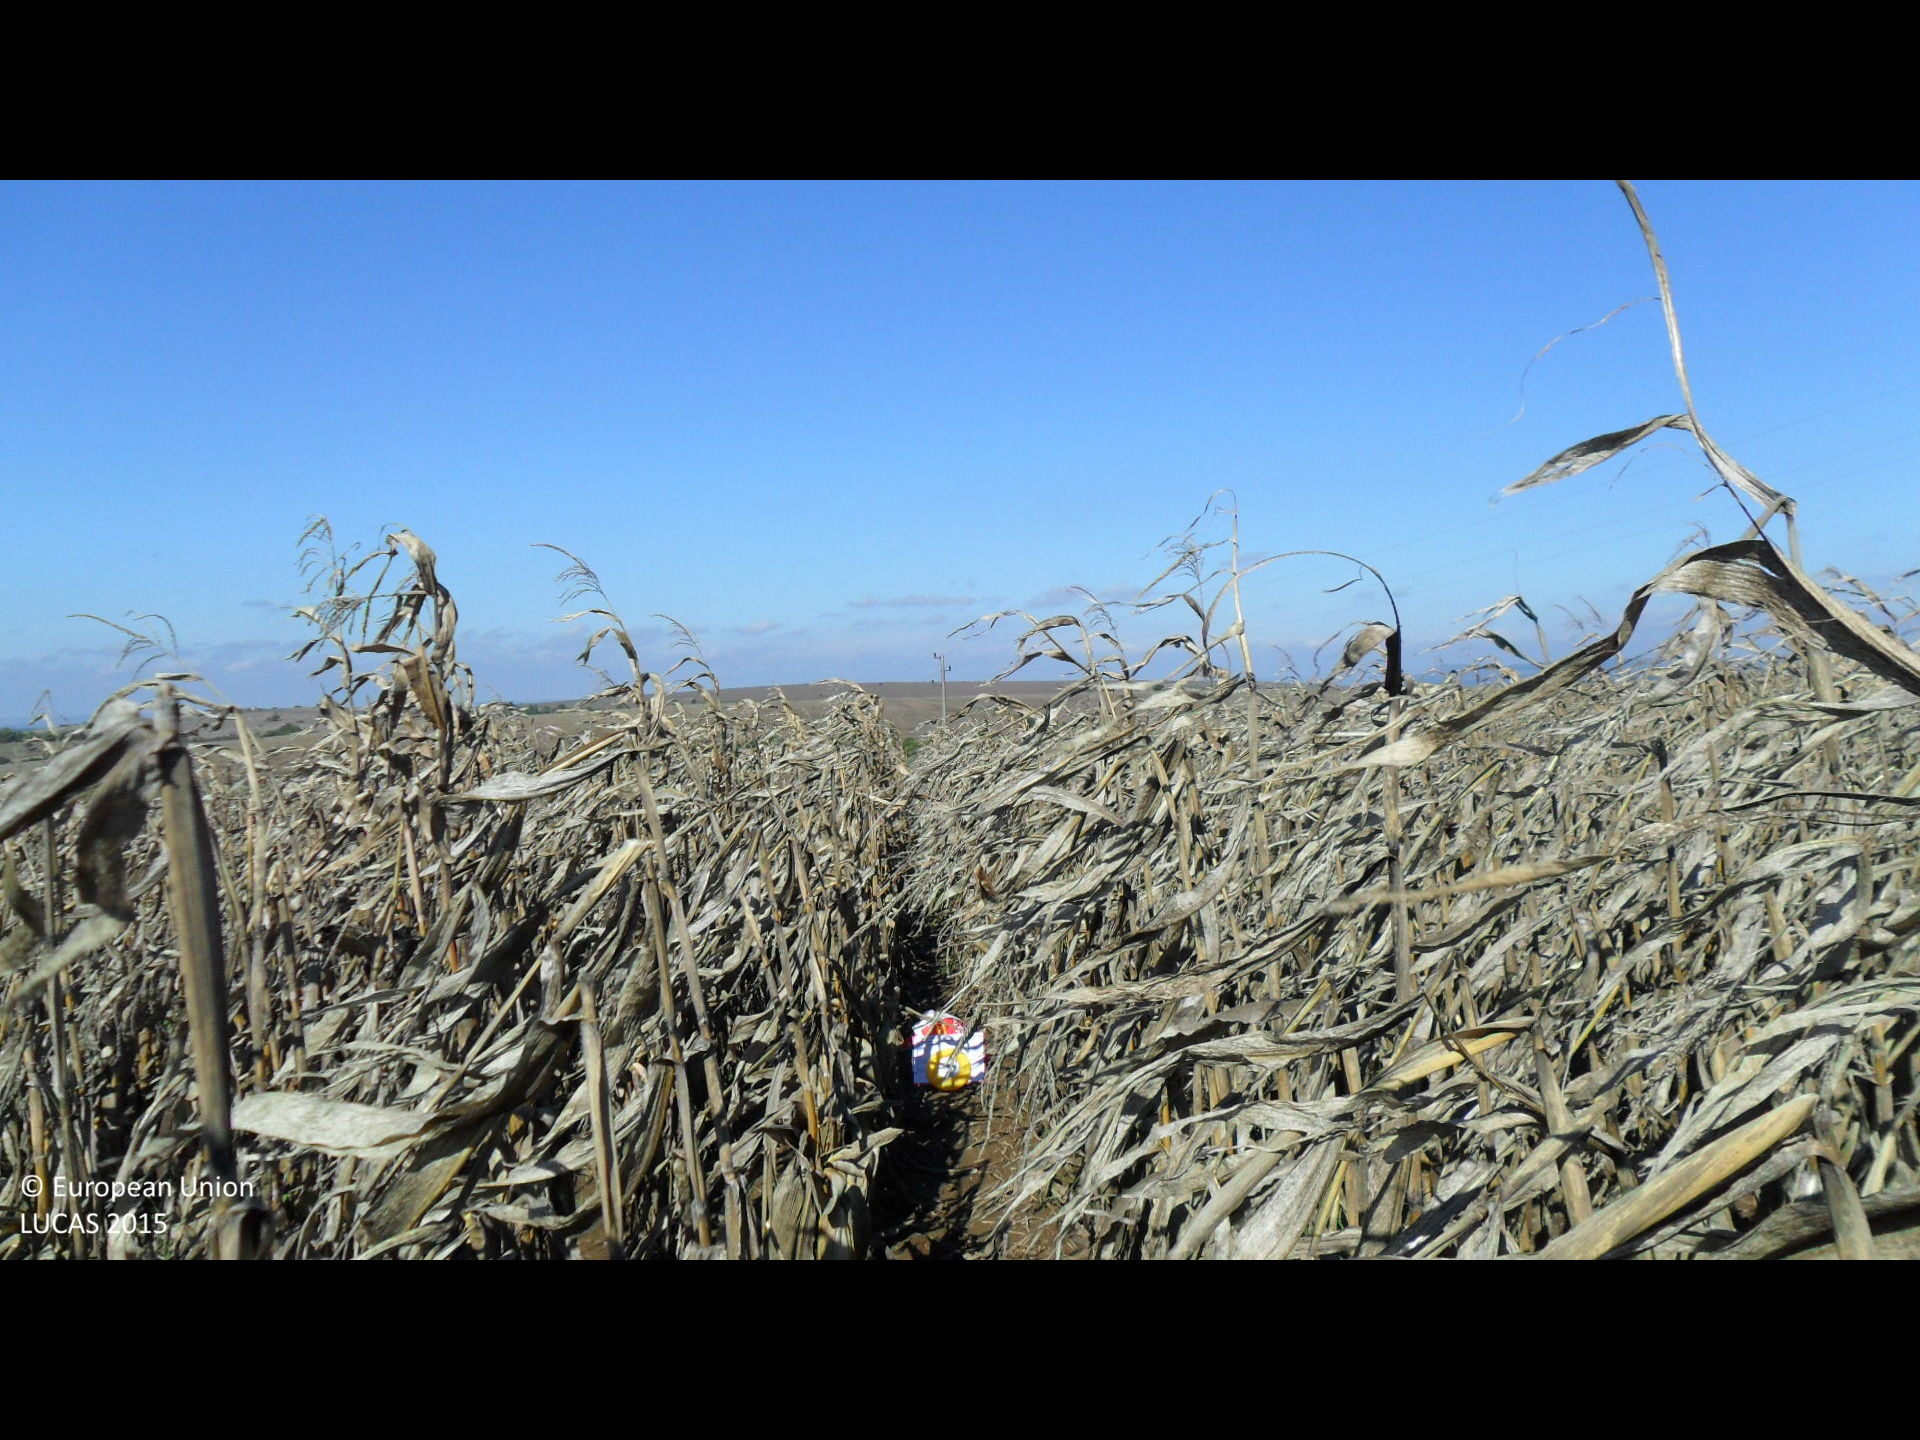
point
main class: Cropland
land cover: Maize
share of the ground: > 75 %
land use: Agriculture (excluding fallow land and kitchen gardens)
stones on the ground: < 10 %
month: October
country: BG
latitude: 43.2015
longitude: 26.2795
